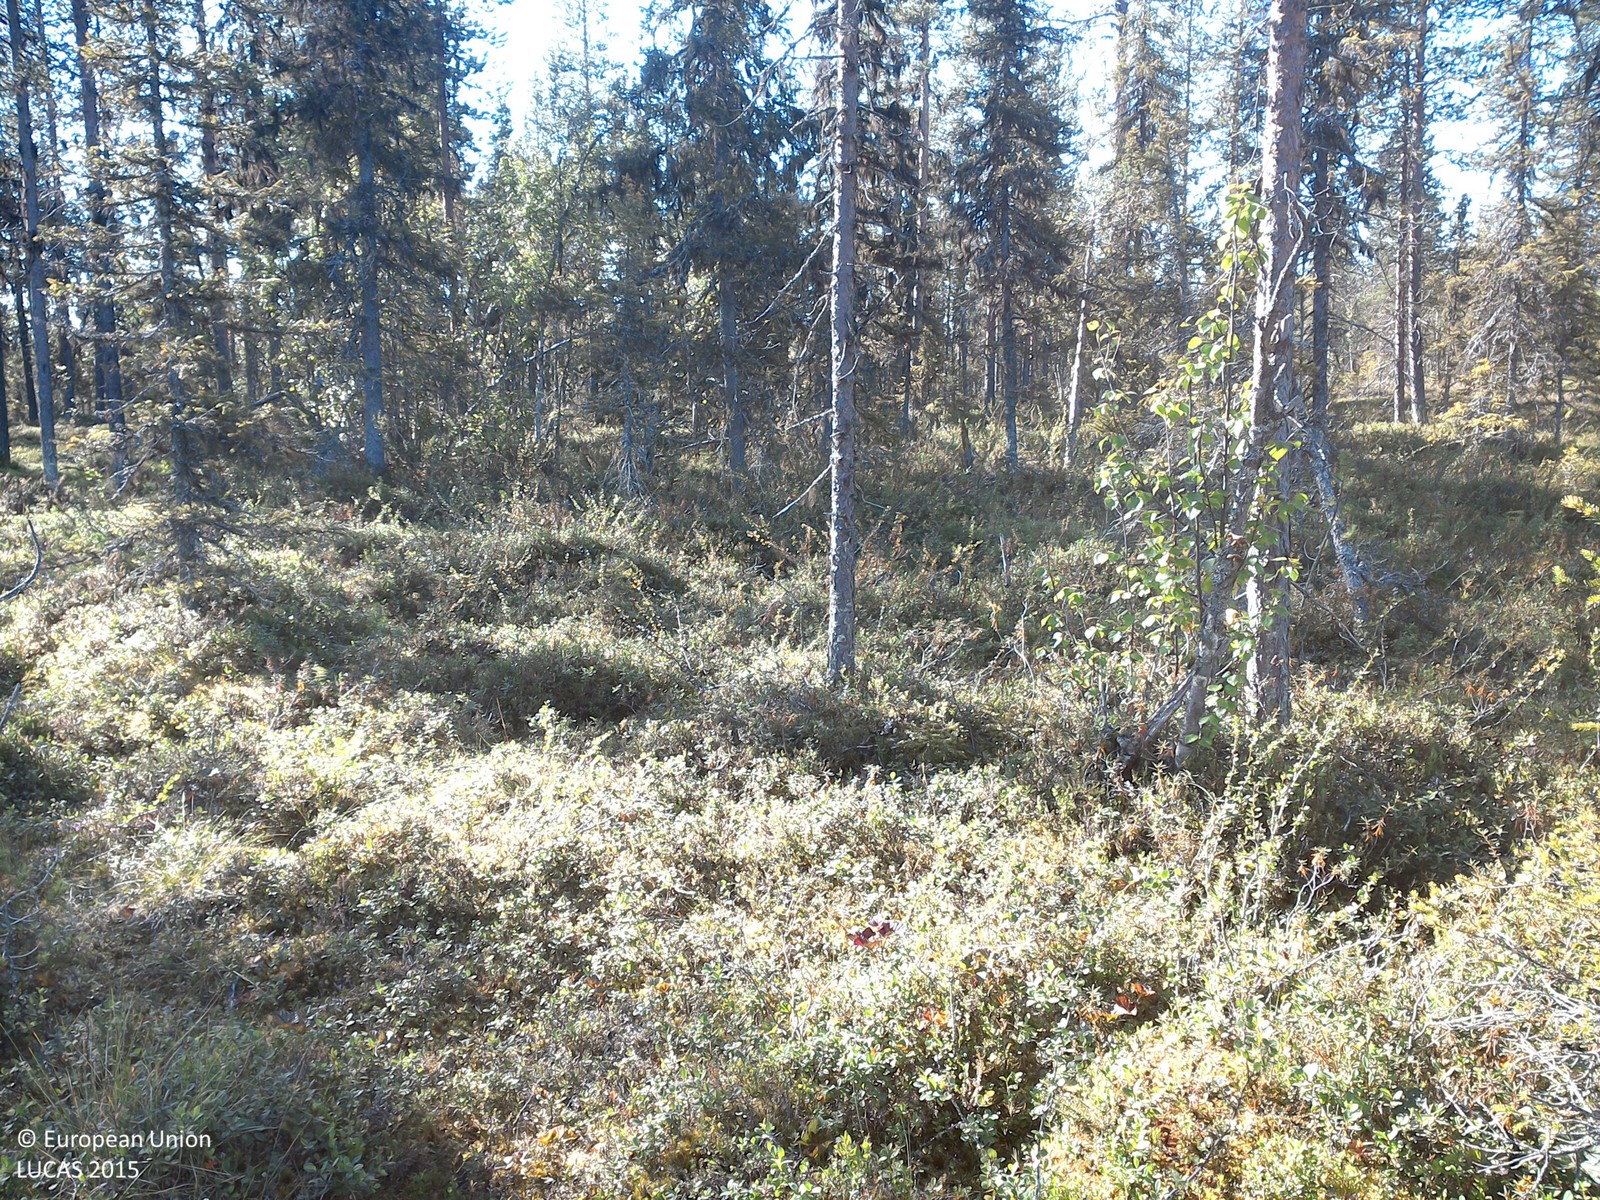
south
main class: Woodland
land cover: Pine dominated coniferous woodland
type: boreal forest
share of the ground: 25 - 50 %
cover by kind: shrubs 65 %, coniferous forest trees 20 %, broadleaved forest trees 5 %, herbaceous plants 5 %, lichens and mosses 5 %
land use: Semi-natural and natural areas not in use
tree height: > 5 m
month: August
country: SE
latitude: 67.2239
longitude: 21.4574
